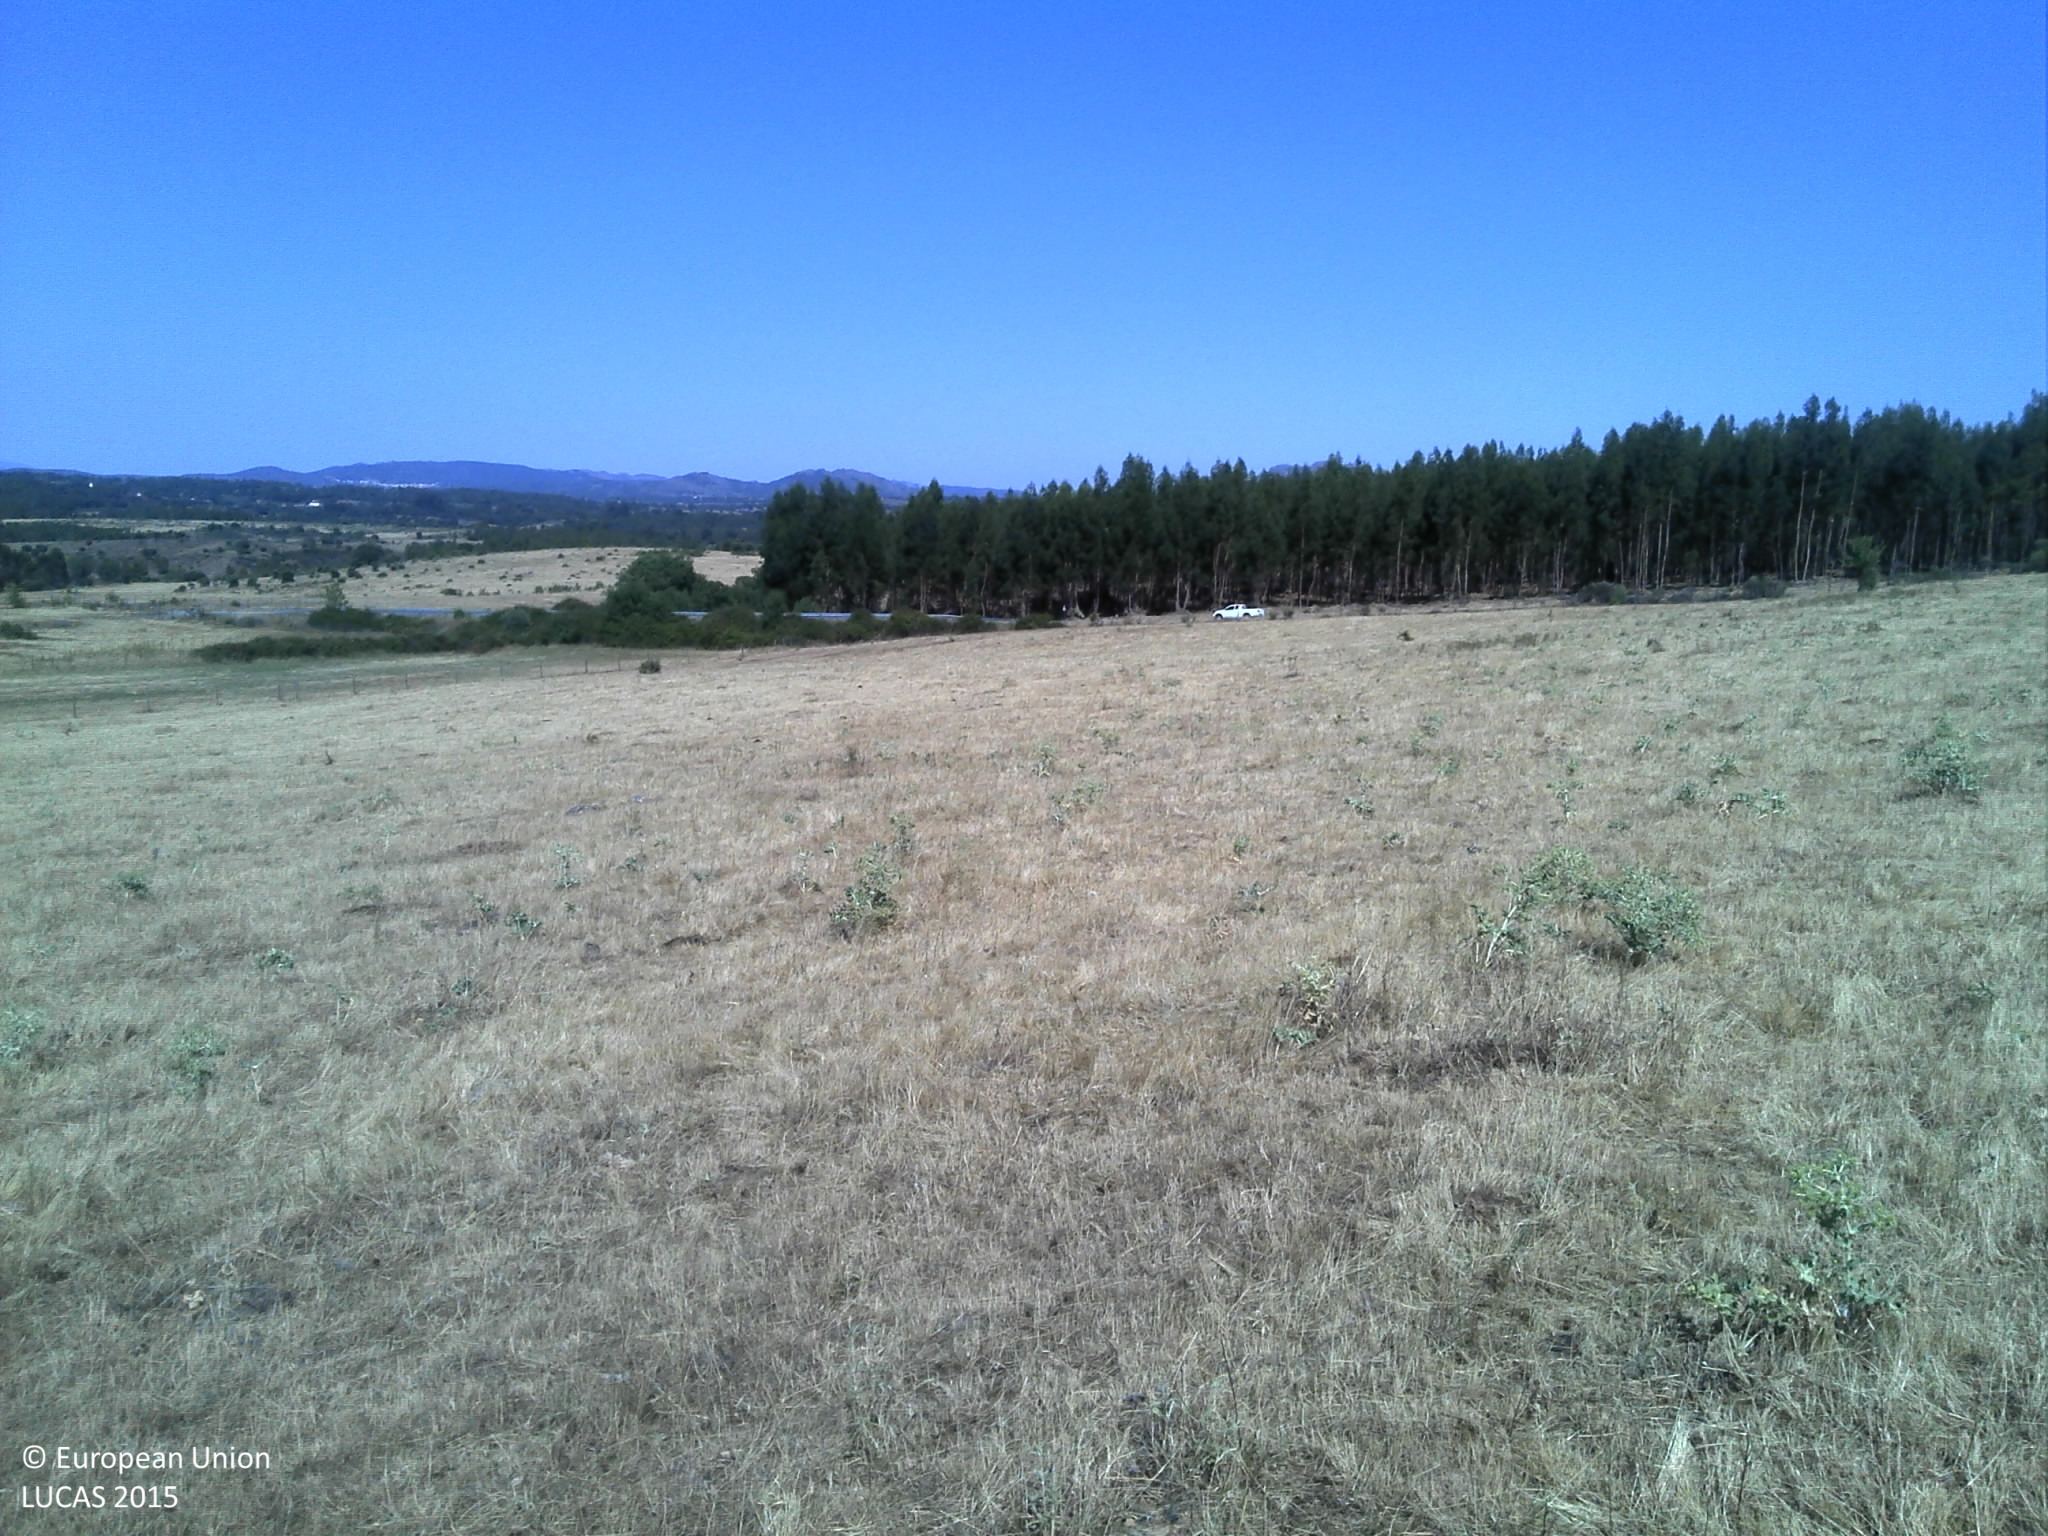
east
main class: Grassland
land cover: Grassland without tree/shrub cover
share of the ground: 50 - 75 %
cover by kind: herbaceous plants 75 %, unconsolidated bare surface 25 %
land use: Agriculture (excluding fallow land and kitchen gardens)
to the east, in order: Grassland without tree/shrub cover; Fences; Grass margins; Paved roads, cycling and walking lanes; Grass margins; Tracks; Broadleaved woodland
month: June
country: PT
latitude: 40.0551
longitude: -7.2475
